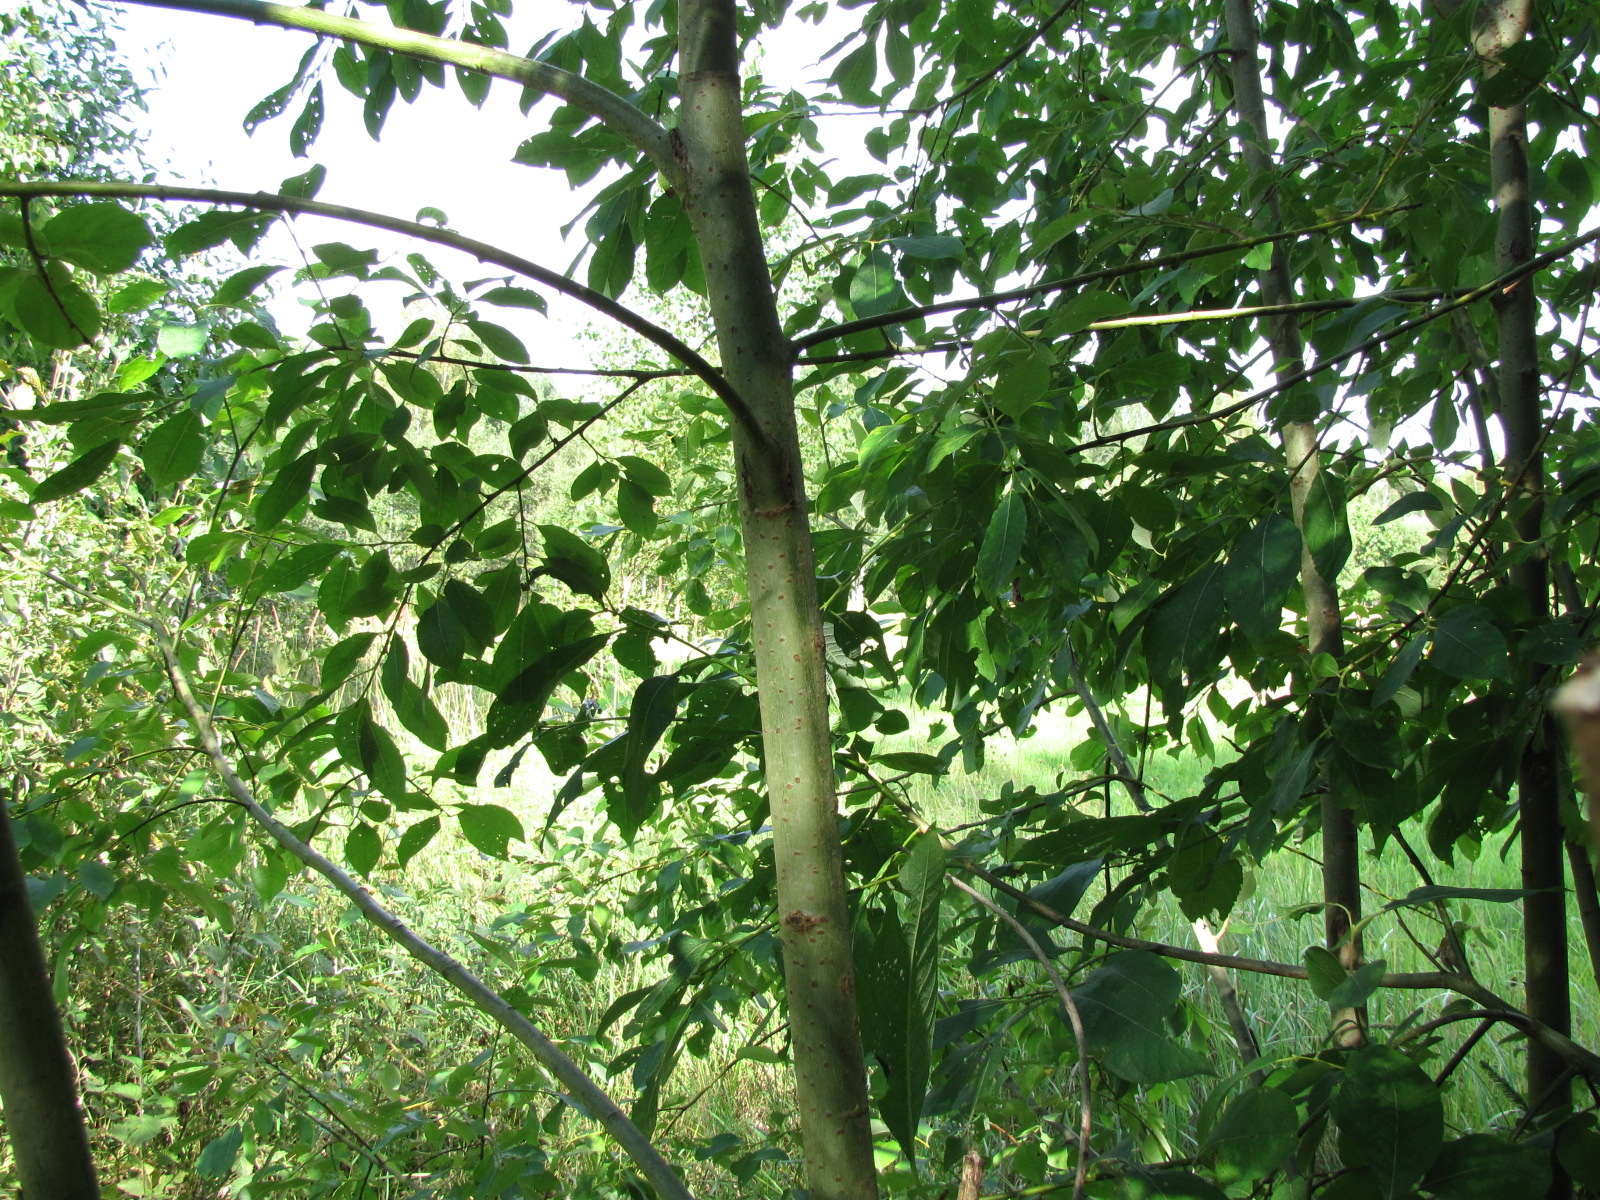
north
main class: Woodland
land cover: Spruce dominated coniferous woodland
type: hemiboreal forest and nemoral coniferous forest and mixed broadleaved-coniferous forest
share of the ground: > 75 %
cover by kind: coniferous forest trees 80 %, herbaceous plants 15 %, broadleaved forest trees 5 %
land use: Road transport
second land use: Agriculture (excluding fallow land and kitchen gardens)
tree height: > 5 m
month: August
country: LV
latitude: 57.0117
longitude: 25.2451
